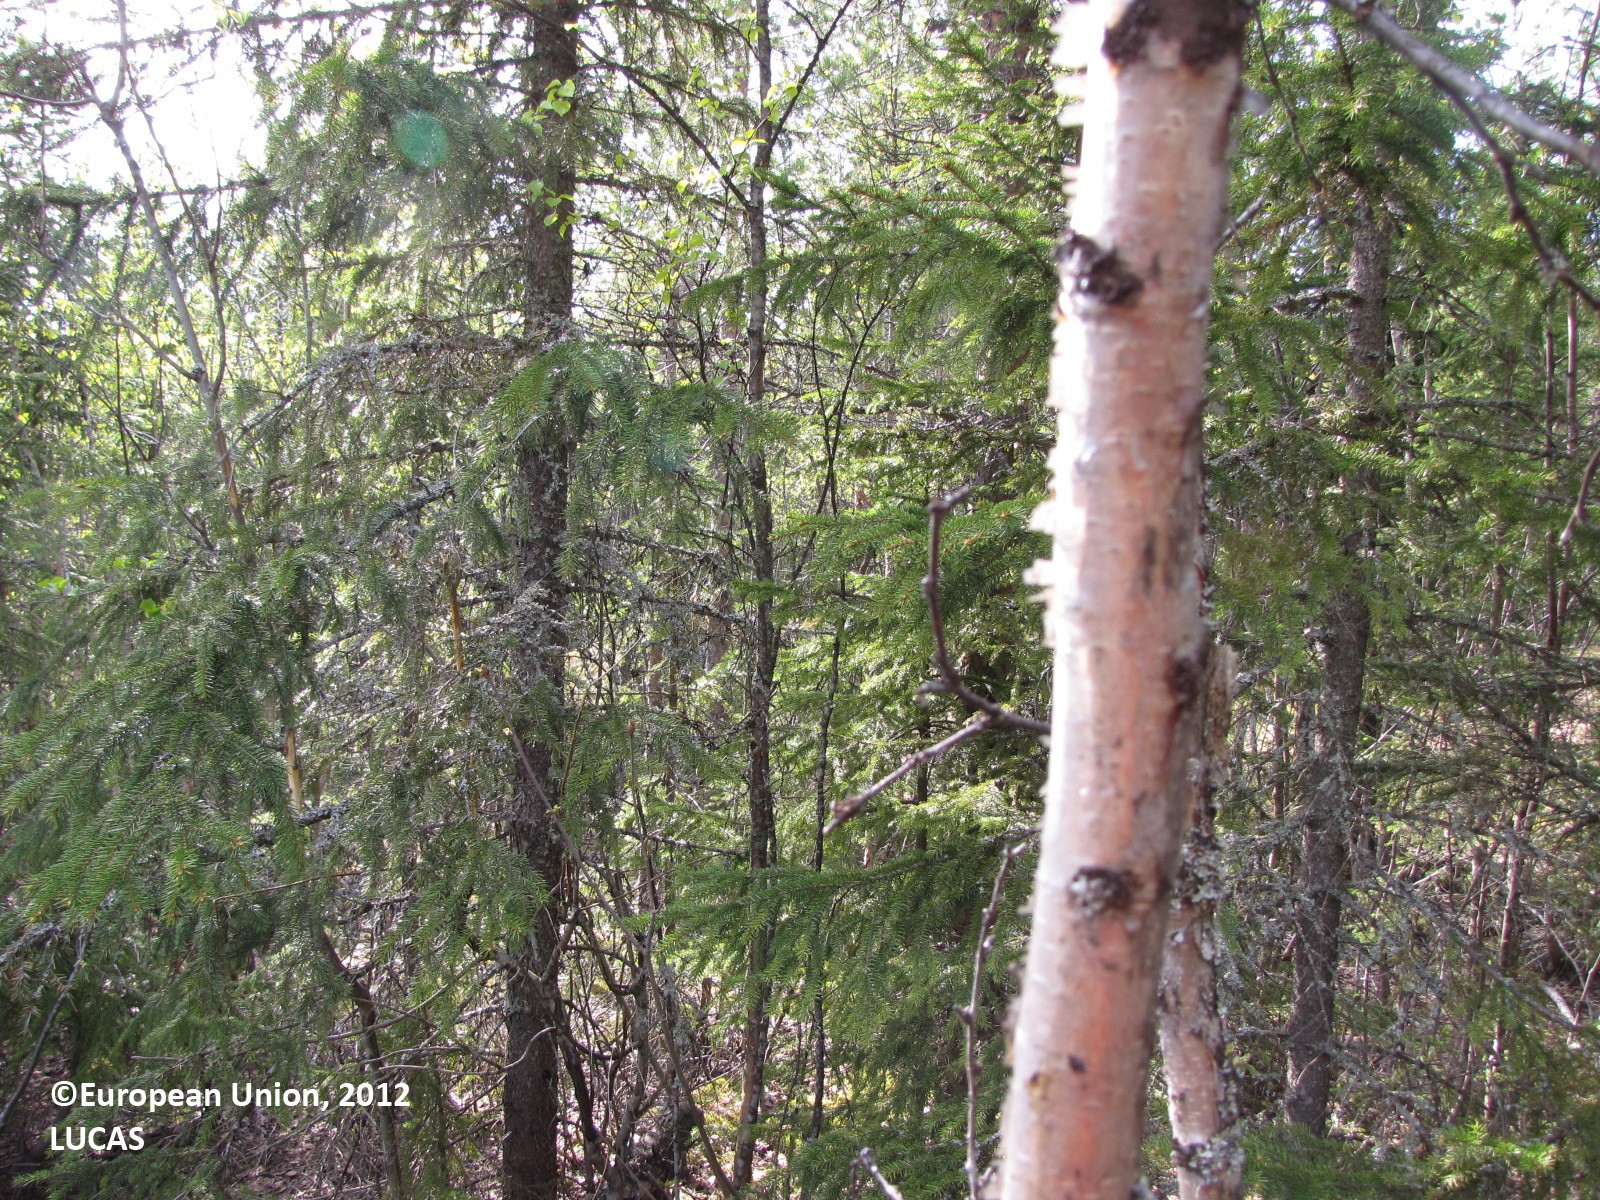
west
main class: Woodland
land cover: Spruce dominated mixed woodland
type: boreal forest
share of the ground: > 75 %
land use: Forestry
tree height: > 5 m
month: May
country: FI
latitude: 65.7959
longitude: 24.6806
